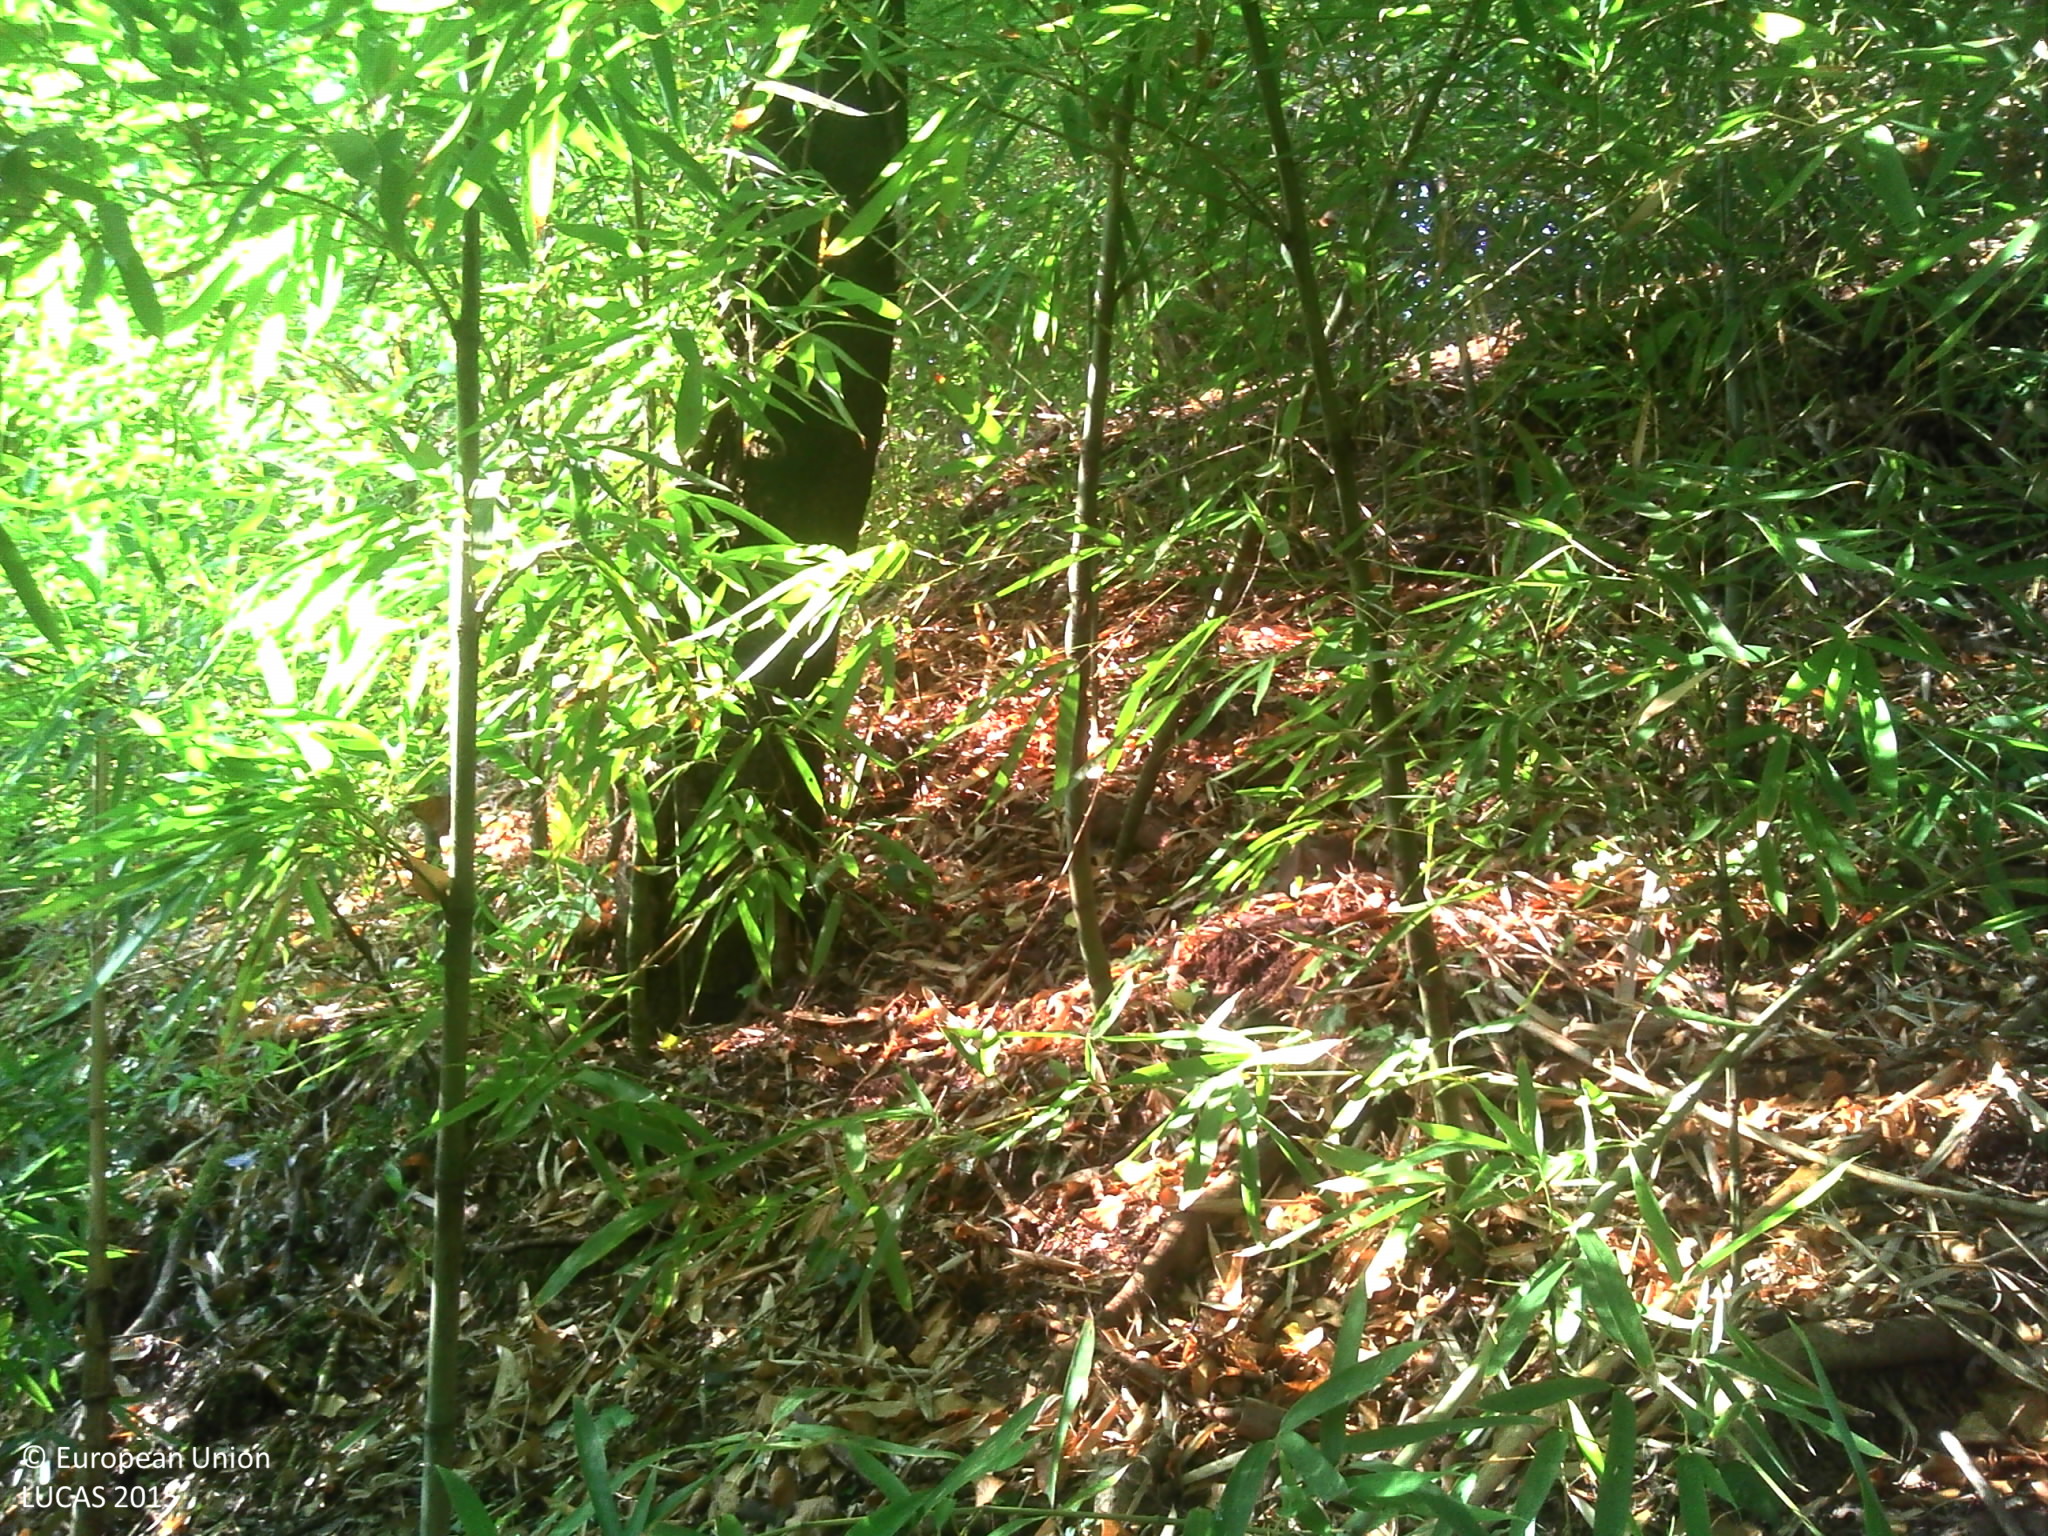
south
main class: Woodland
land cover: Broadleaved woodland
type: boreal forest
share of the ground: > 75 %
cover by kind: broadleaved forest trees 90 %, shrubs 10 %
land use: Semi-natural and natural areas not in use
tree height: > 5 m
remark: Temporary flooded
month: July
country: FR
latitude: 43.3840
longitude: 6.3675
